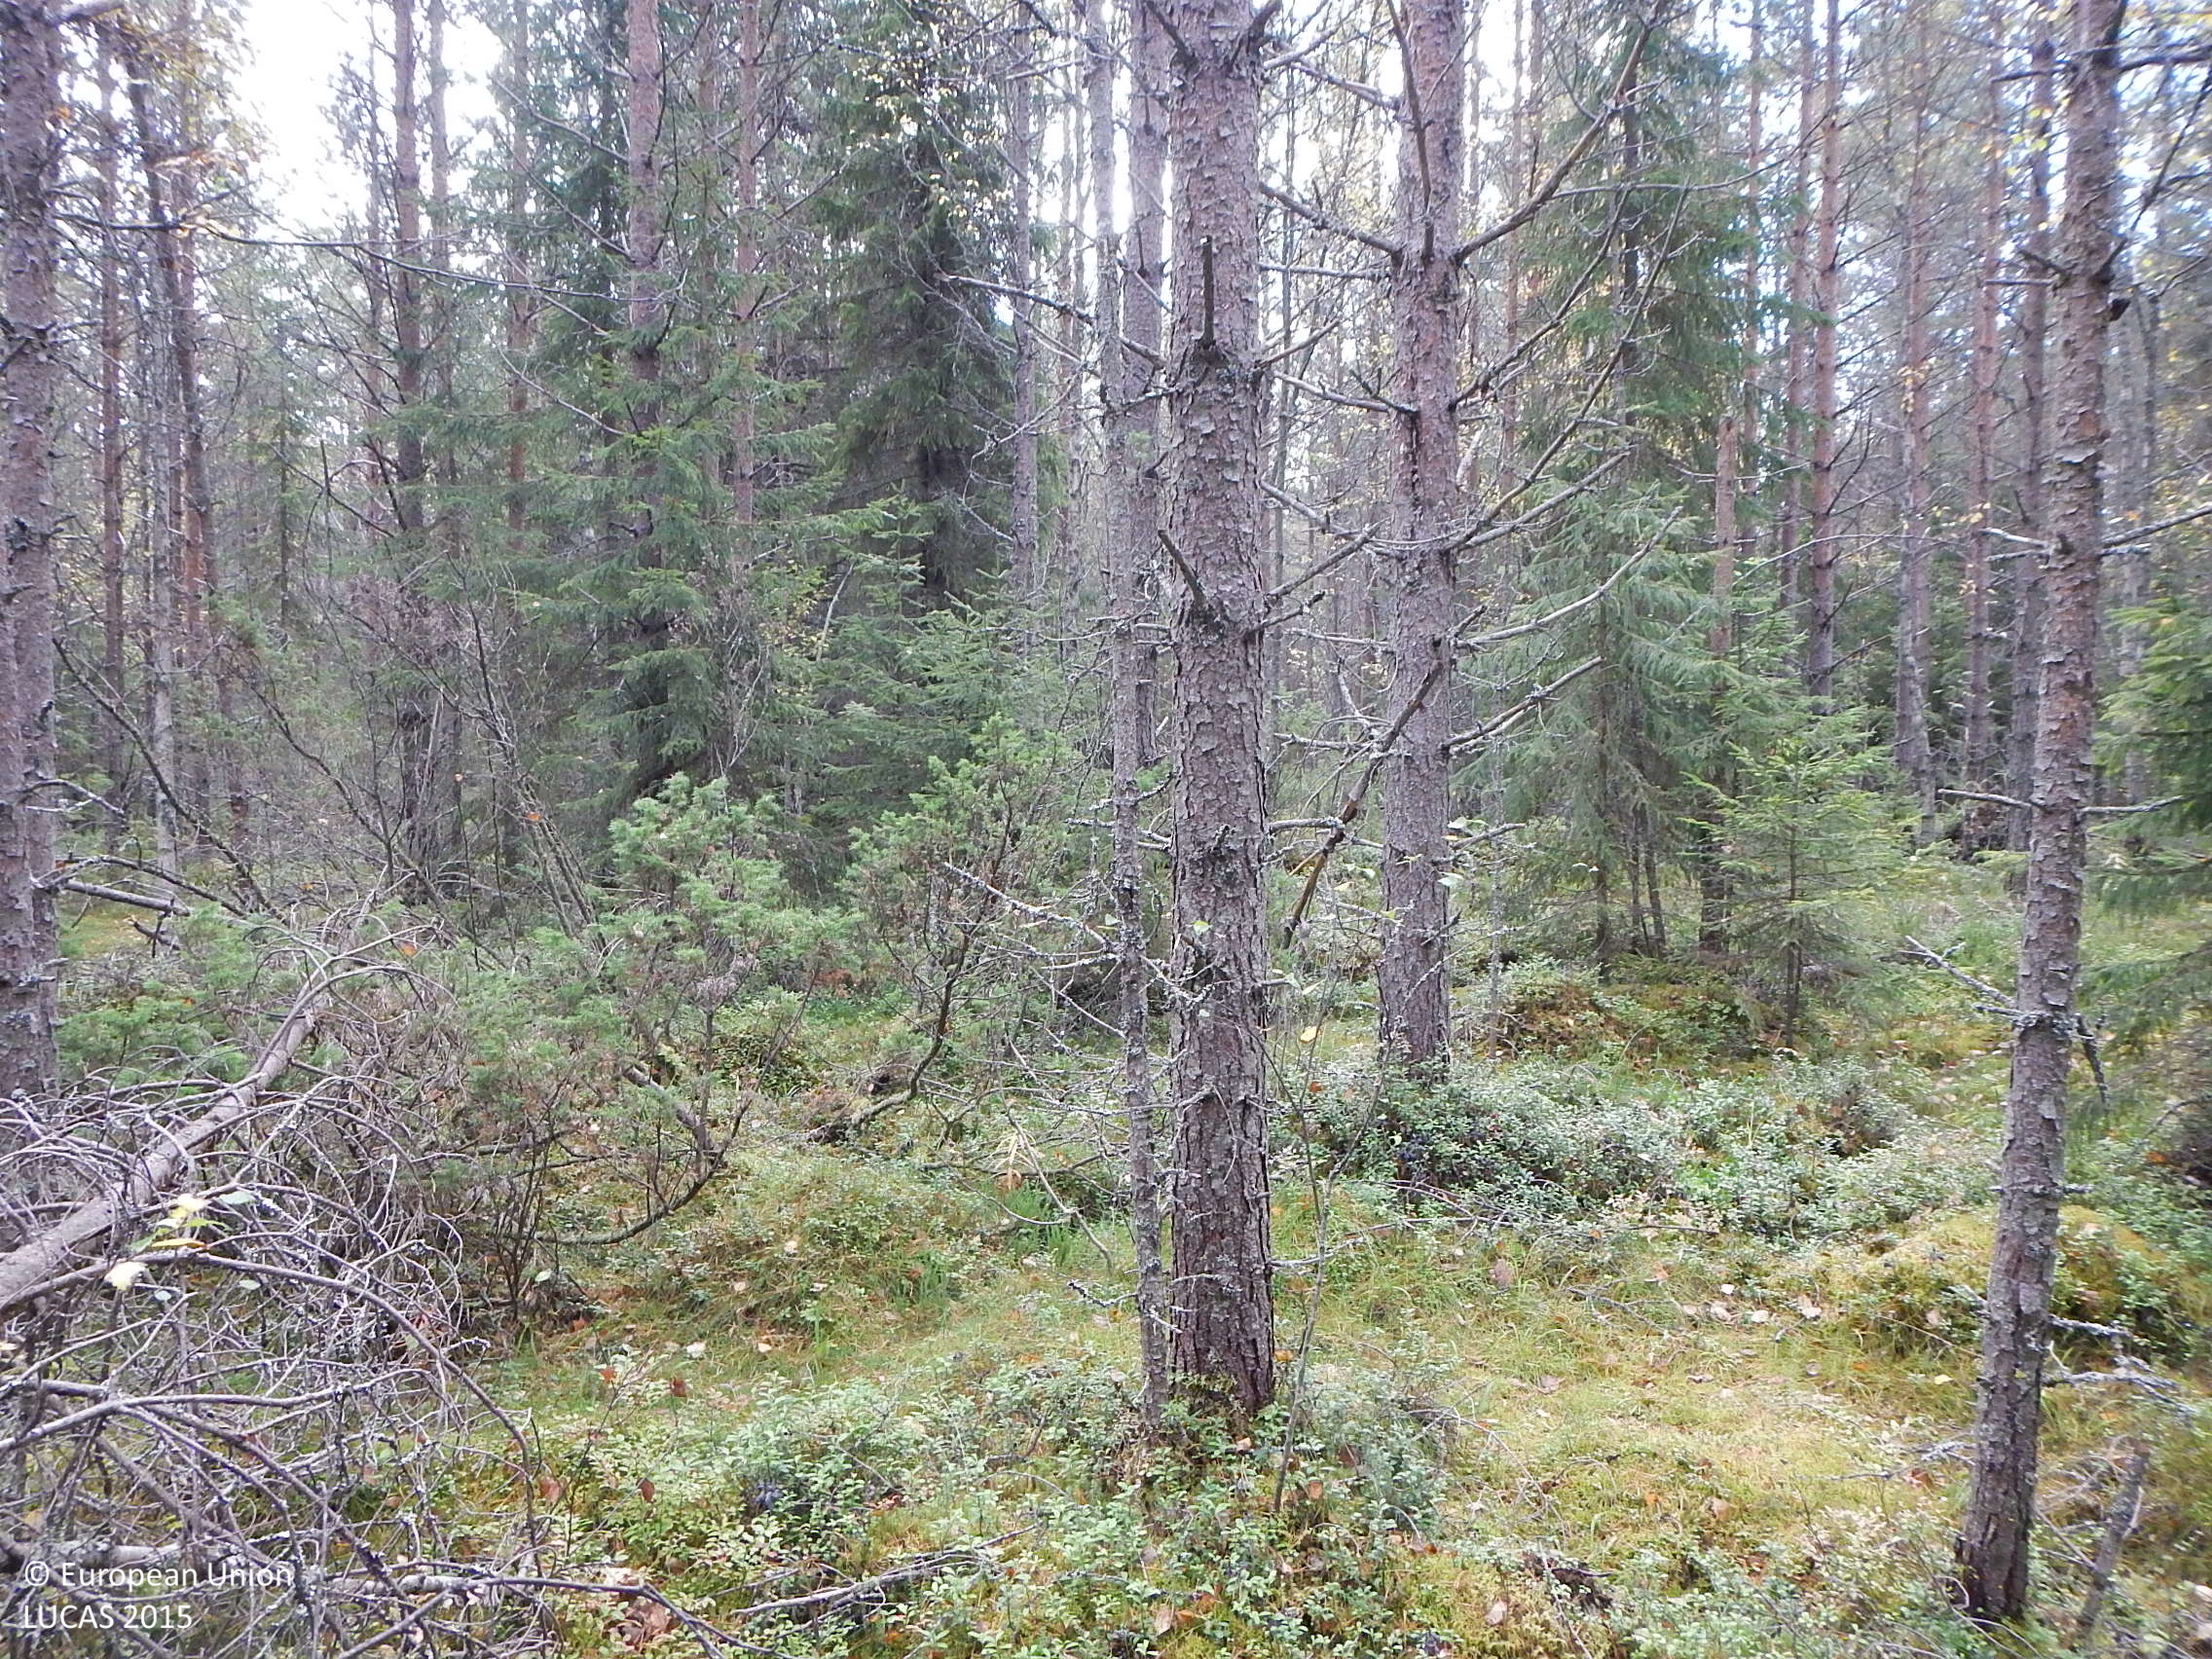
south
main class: Woodland
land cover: Other mixed woodland
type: boreal forest
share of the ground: 50 - 75 %
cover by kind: coniferous forest trees 40 %, broadleaved forest trees 25 %, shrubs 20 %, lichens and mosses 10 %, herbaceous plants 5 %
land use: Forestry
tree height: > 5 m
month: September
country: FI
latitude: 62.0016
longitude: 22.8778
